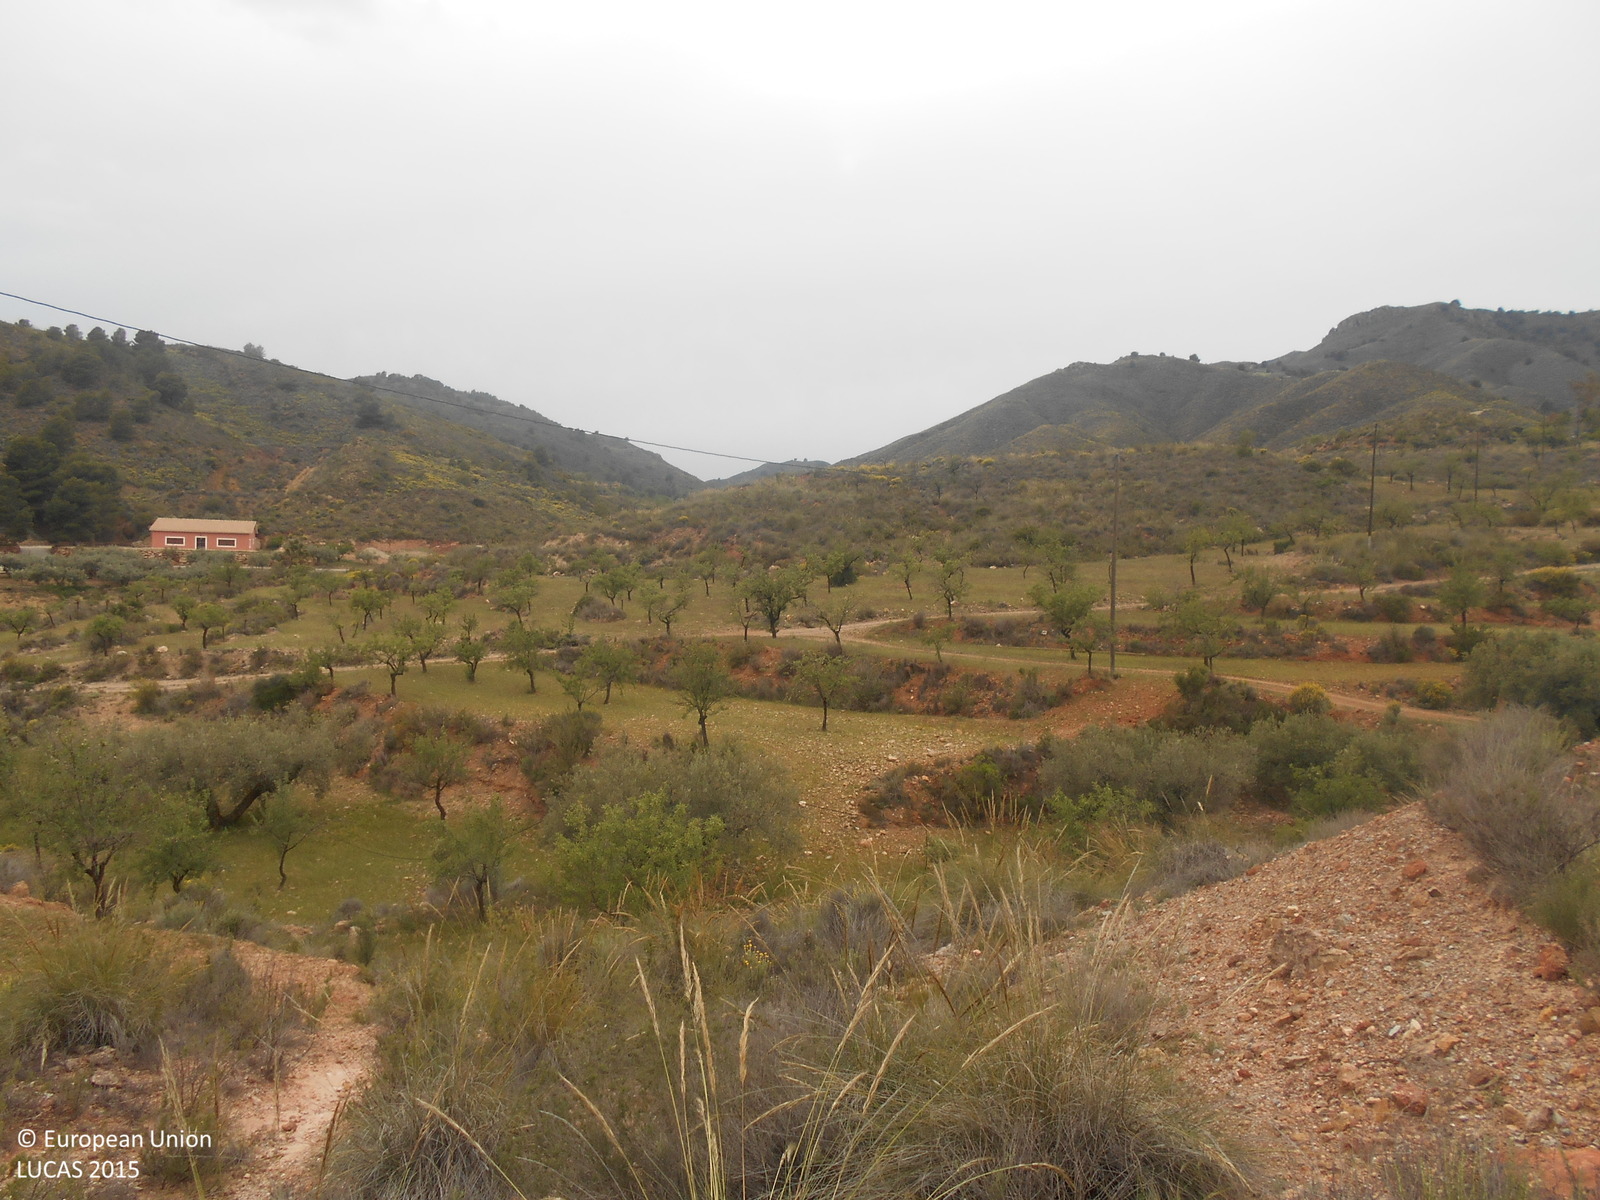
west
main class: Shrubland
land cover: Shrubland without tree cover
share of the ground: > 75 %
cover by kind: shrubs 90 %, unconsolidated bare surface 10 %
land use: Semi-natural and natural areas not in use
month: April
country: ES
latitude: 37.5938
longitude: -1.5216
